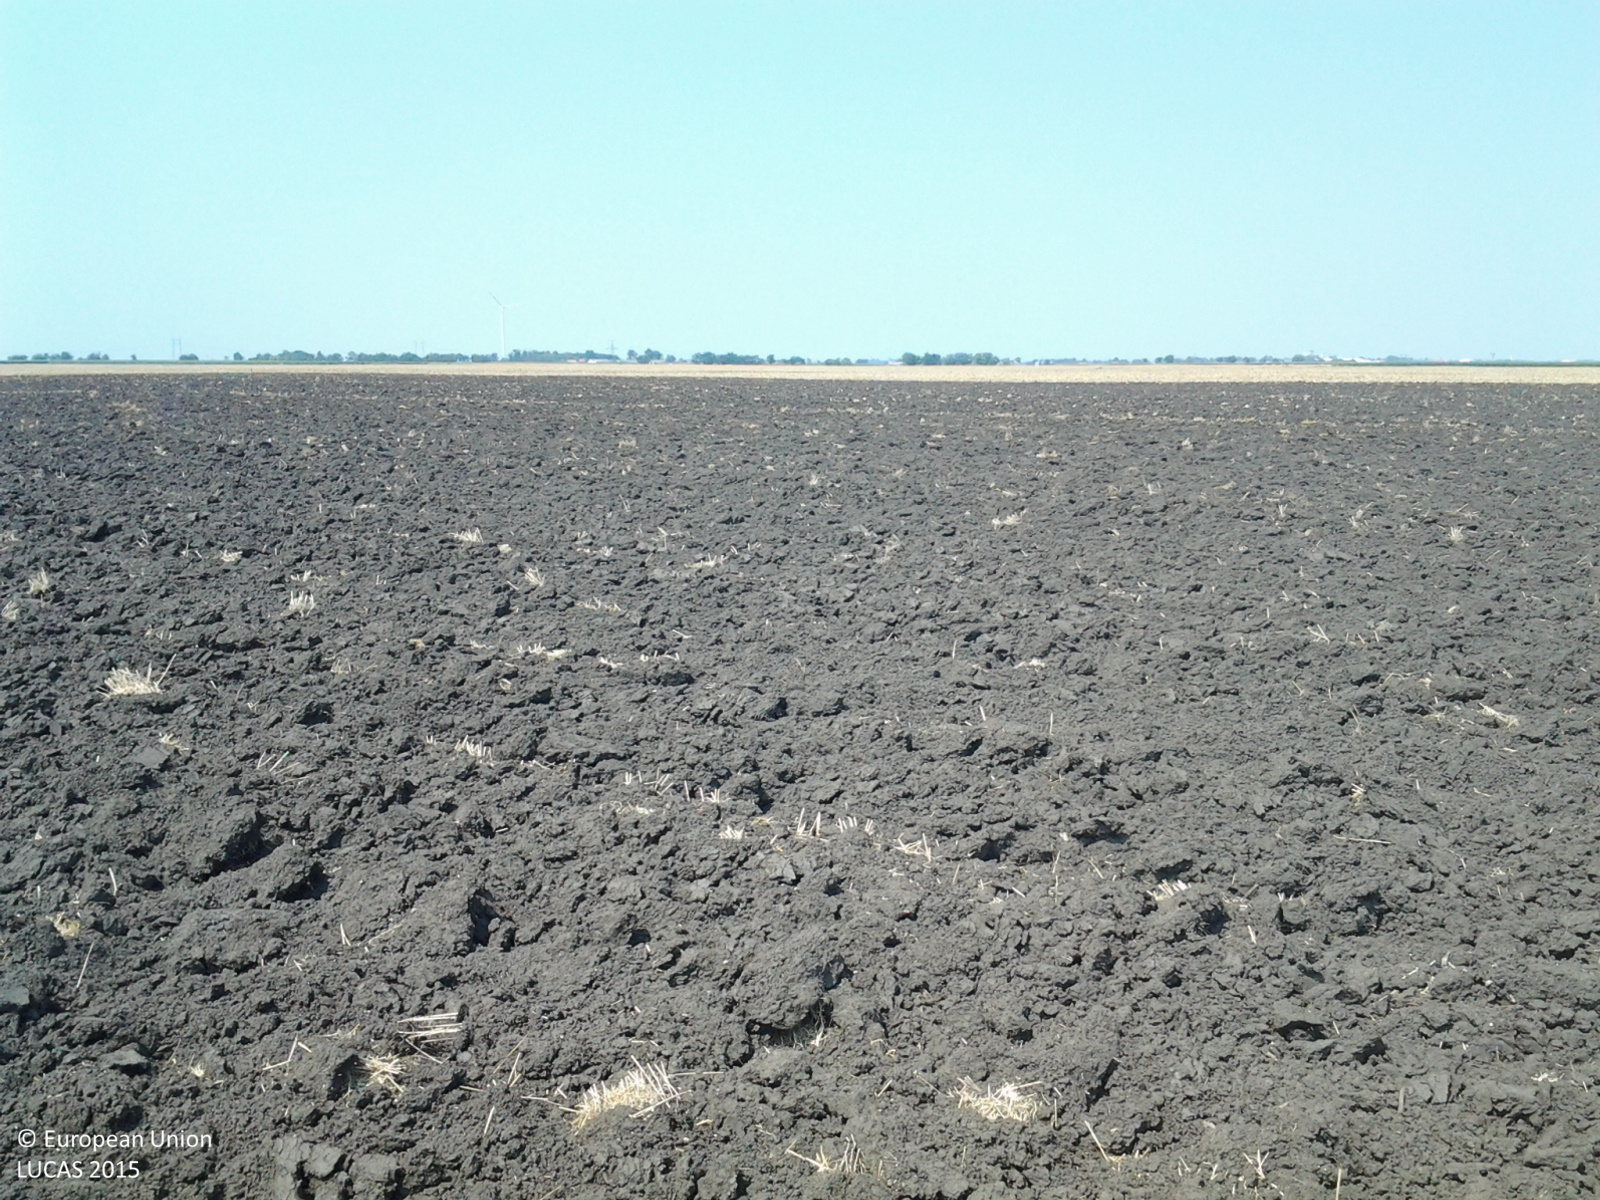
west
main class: Cropland
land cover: Common wheat
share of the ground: < 10 %
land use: Agriculture (excluding fallow land and kitchen gardens)
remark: Tilled/Sowed
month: July
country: HU
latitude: 47.1414
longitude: 20.4857
